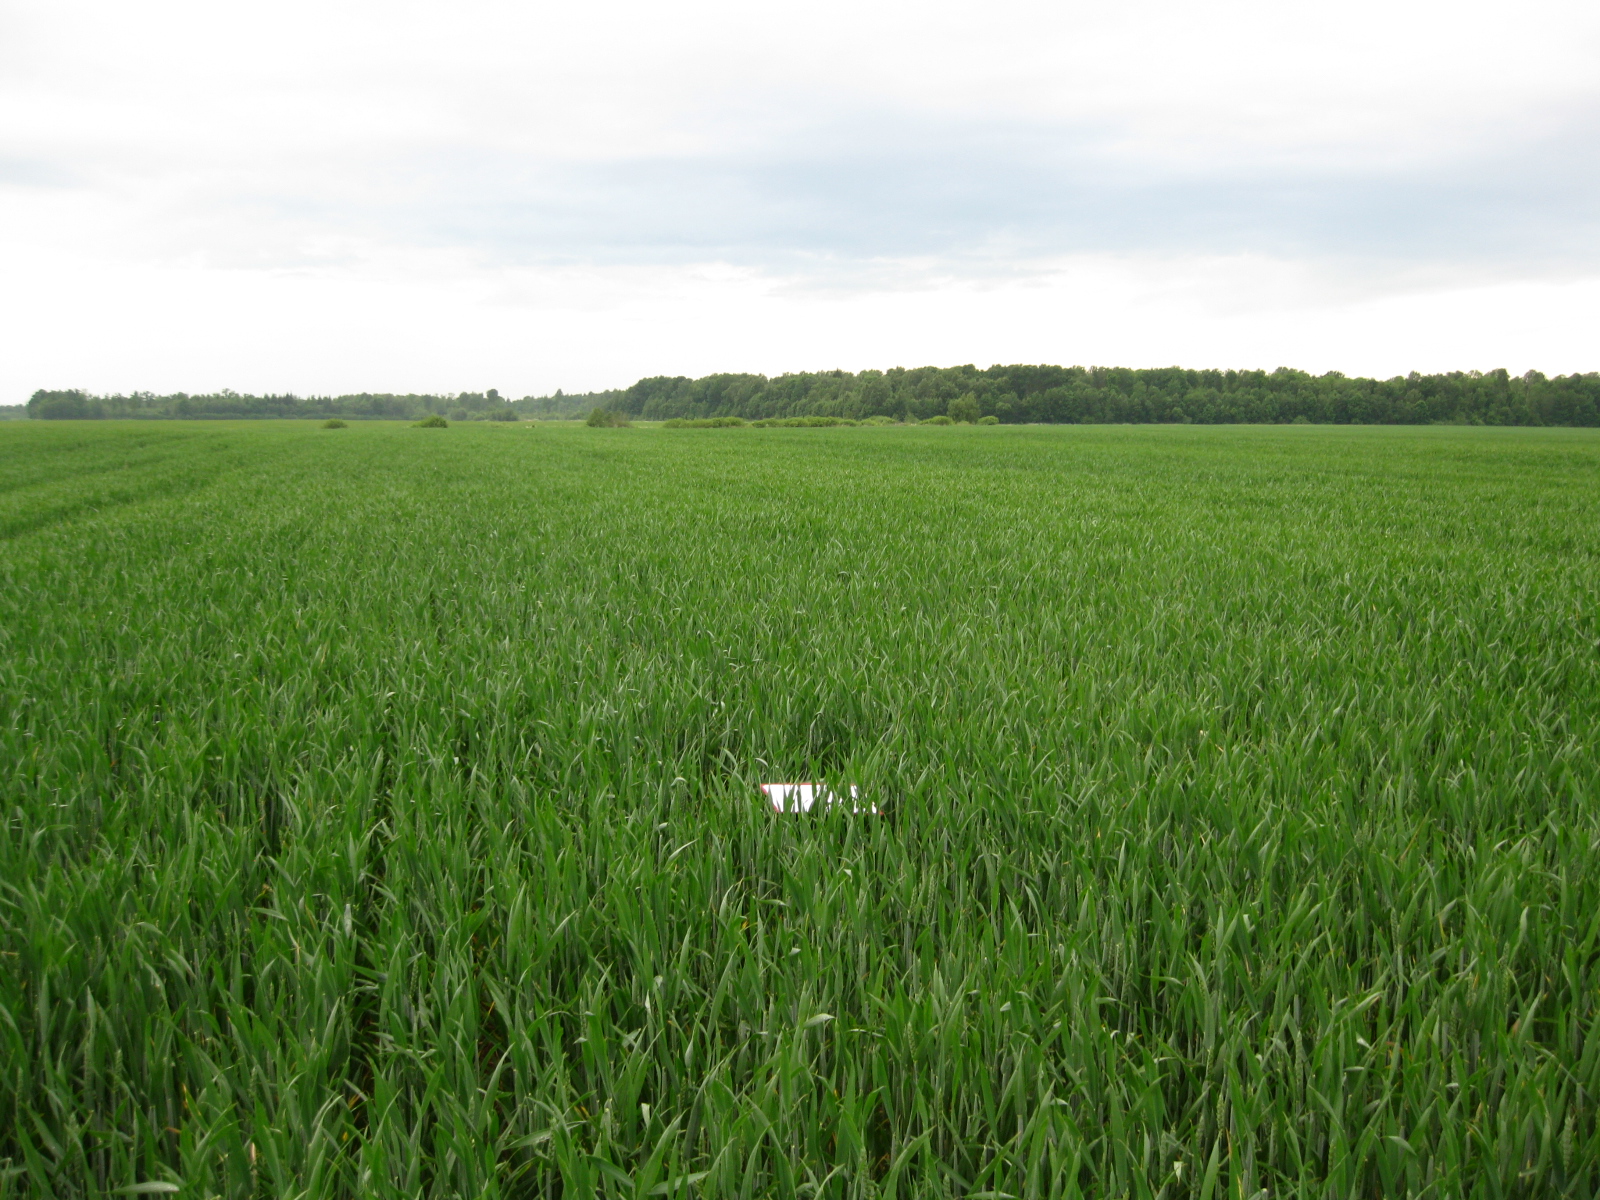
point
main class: Cropland
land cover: Common wheat
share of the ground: > 75 %
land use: Agriculture (excluding fallow land and kitchen gardens)
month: June
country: LT
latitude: 55.6461
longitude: 23.8945
